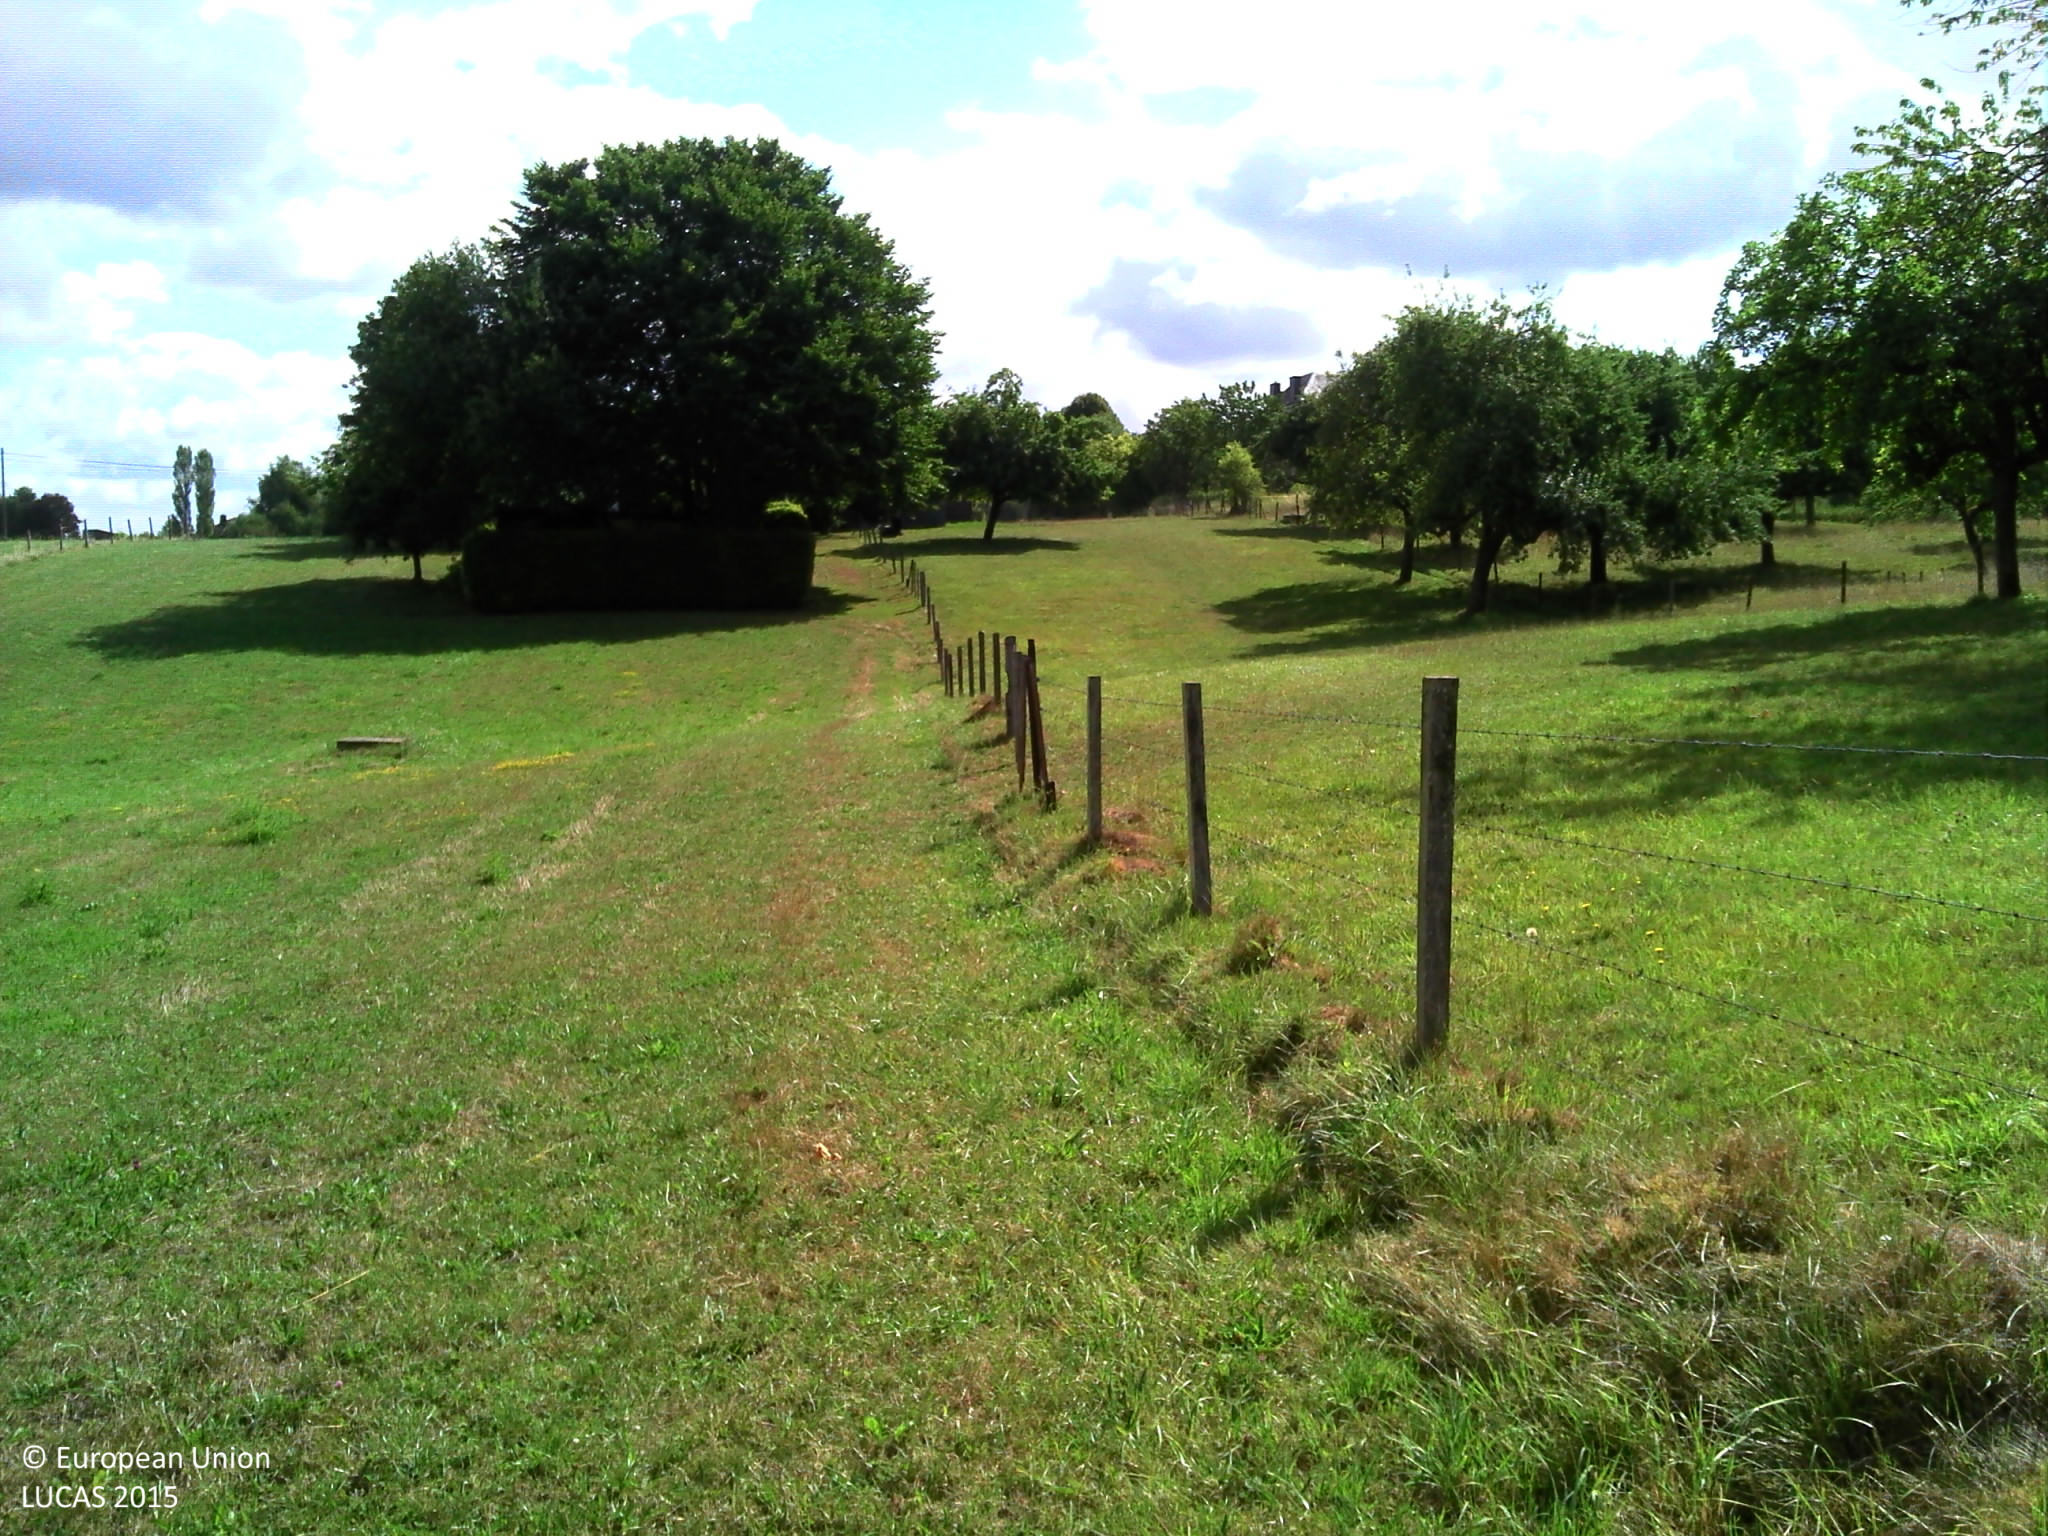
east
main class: Grassland
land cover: Grassland without tree/shrub cover
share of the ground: > 75 %
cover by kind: herbaceous plants 100 %
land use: Agriculture (excluding fallow land and kitchen gardens)
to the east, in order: Grassland without tree/shrub cover; Fences; Grassland without tree/shrub cover; Fences; Grassland without tree/shrub cover; Fences; Spontaneously vegetated surfaces; Artificial constructions in urban areas; Ditches and canals; Grass margins; Fences; Grassland without tree/shrub cover
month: July
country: BE
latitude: 49.5765
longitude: 5.5870
